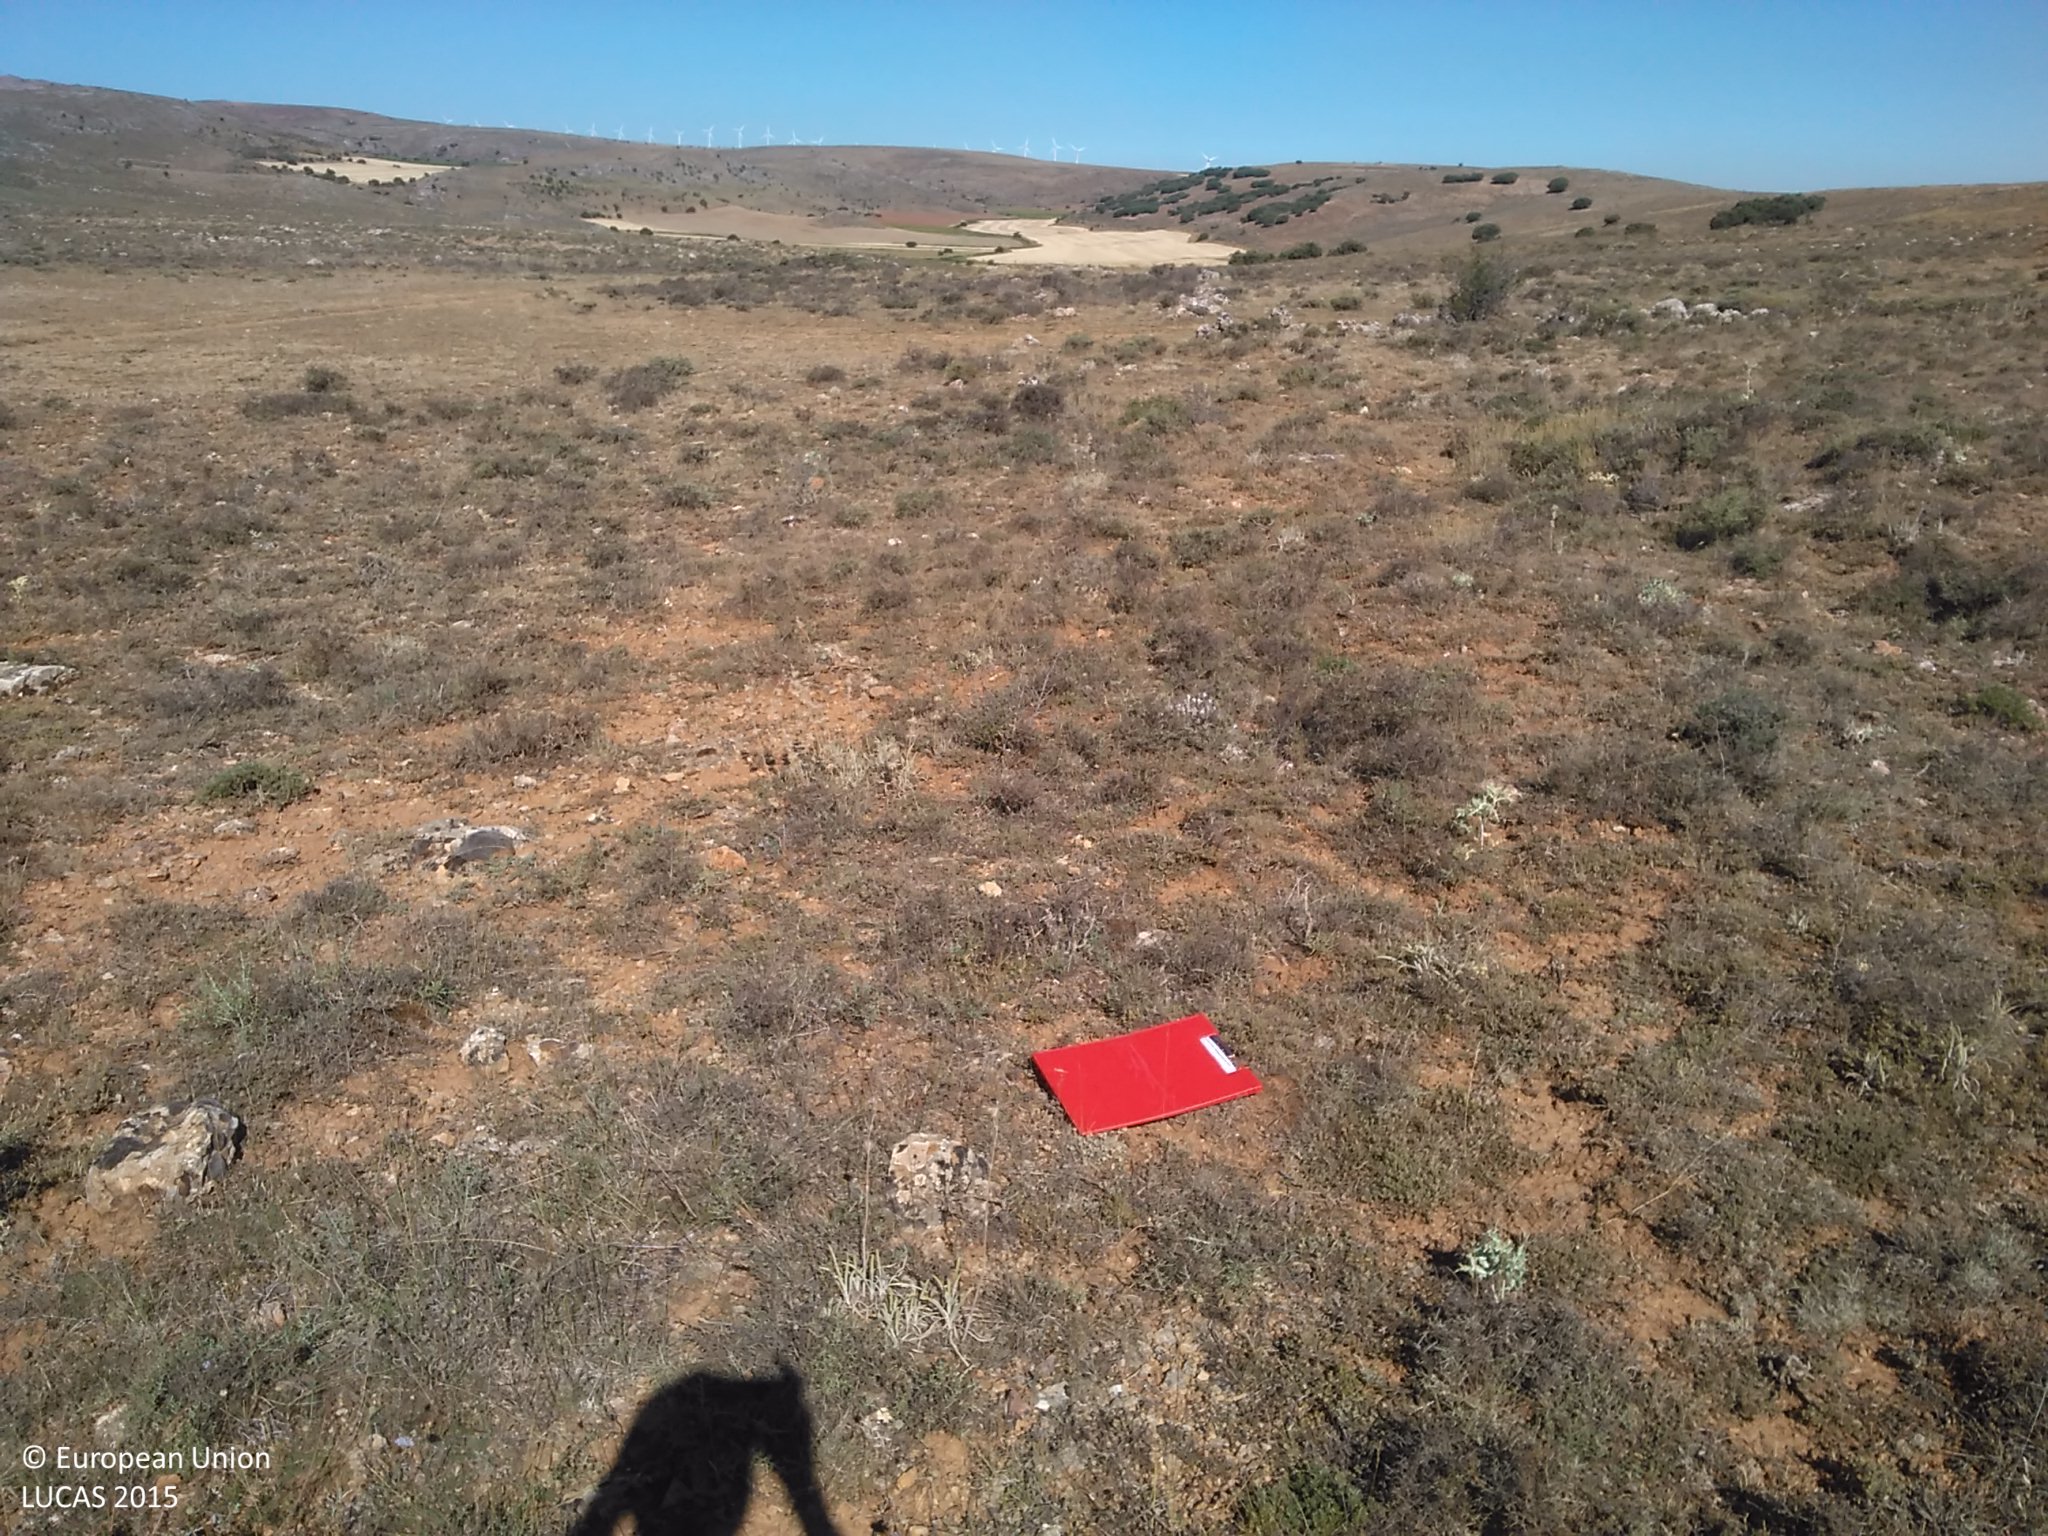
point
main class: Shrubland
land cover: Shrubland without tree cover
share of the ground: 50 - 75 %
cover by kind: shrubs 60 %, unconsolidated bare surface 40 %
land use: Semi-natural and natural areas not in use
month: July
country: ES
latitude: 41.2893
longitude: -2.9465
